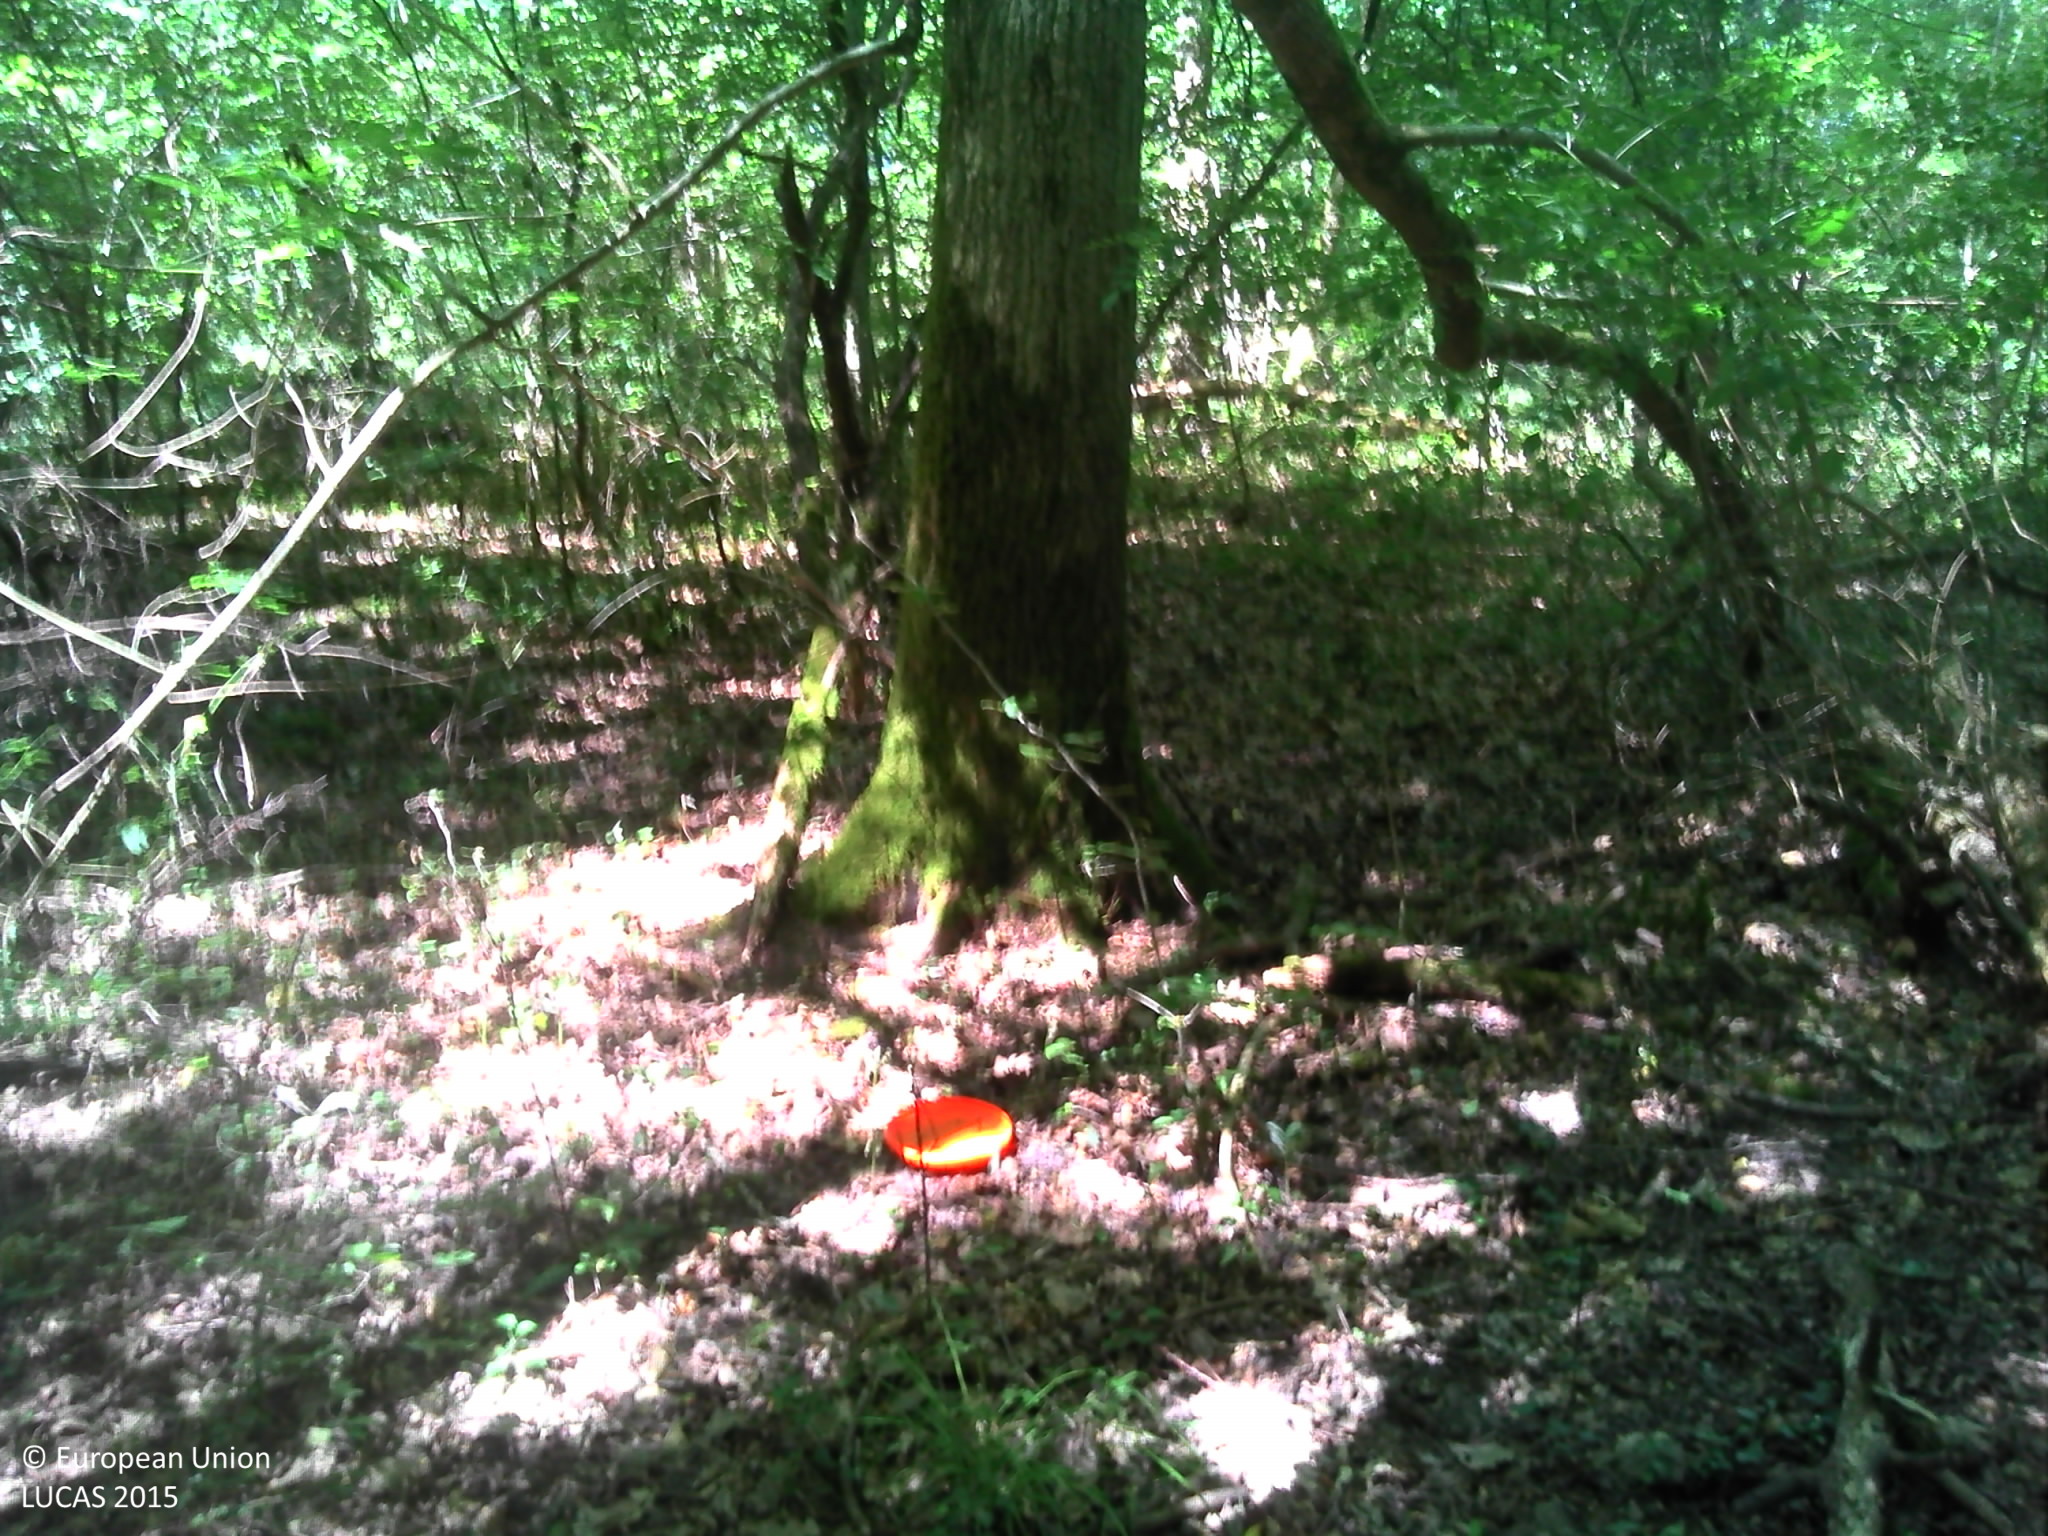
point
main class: Woodland
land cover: Broadleaved woodland
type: mesophytic deciduous forest
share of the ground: > 75 %
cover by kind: broadleaved forest trees 85 %, shrubs 5 %, herbaceous plants 5 %, lichens and mosses 5 %
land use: Forestry
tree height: > 5 m
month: July
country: FR
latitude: 47.2714
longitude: 0.5287
